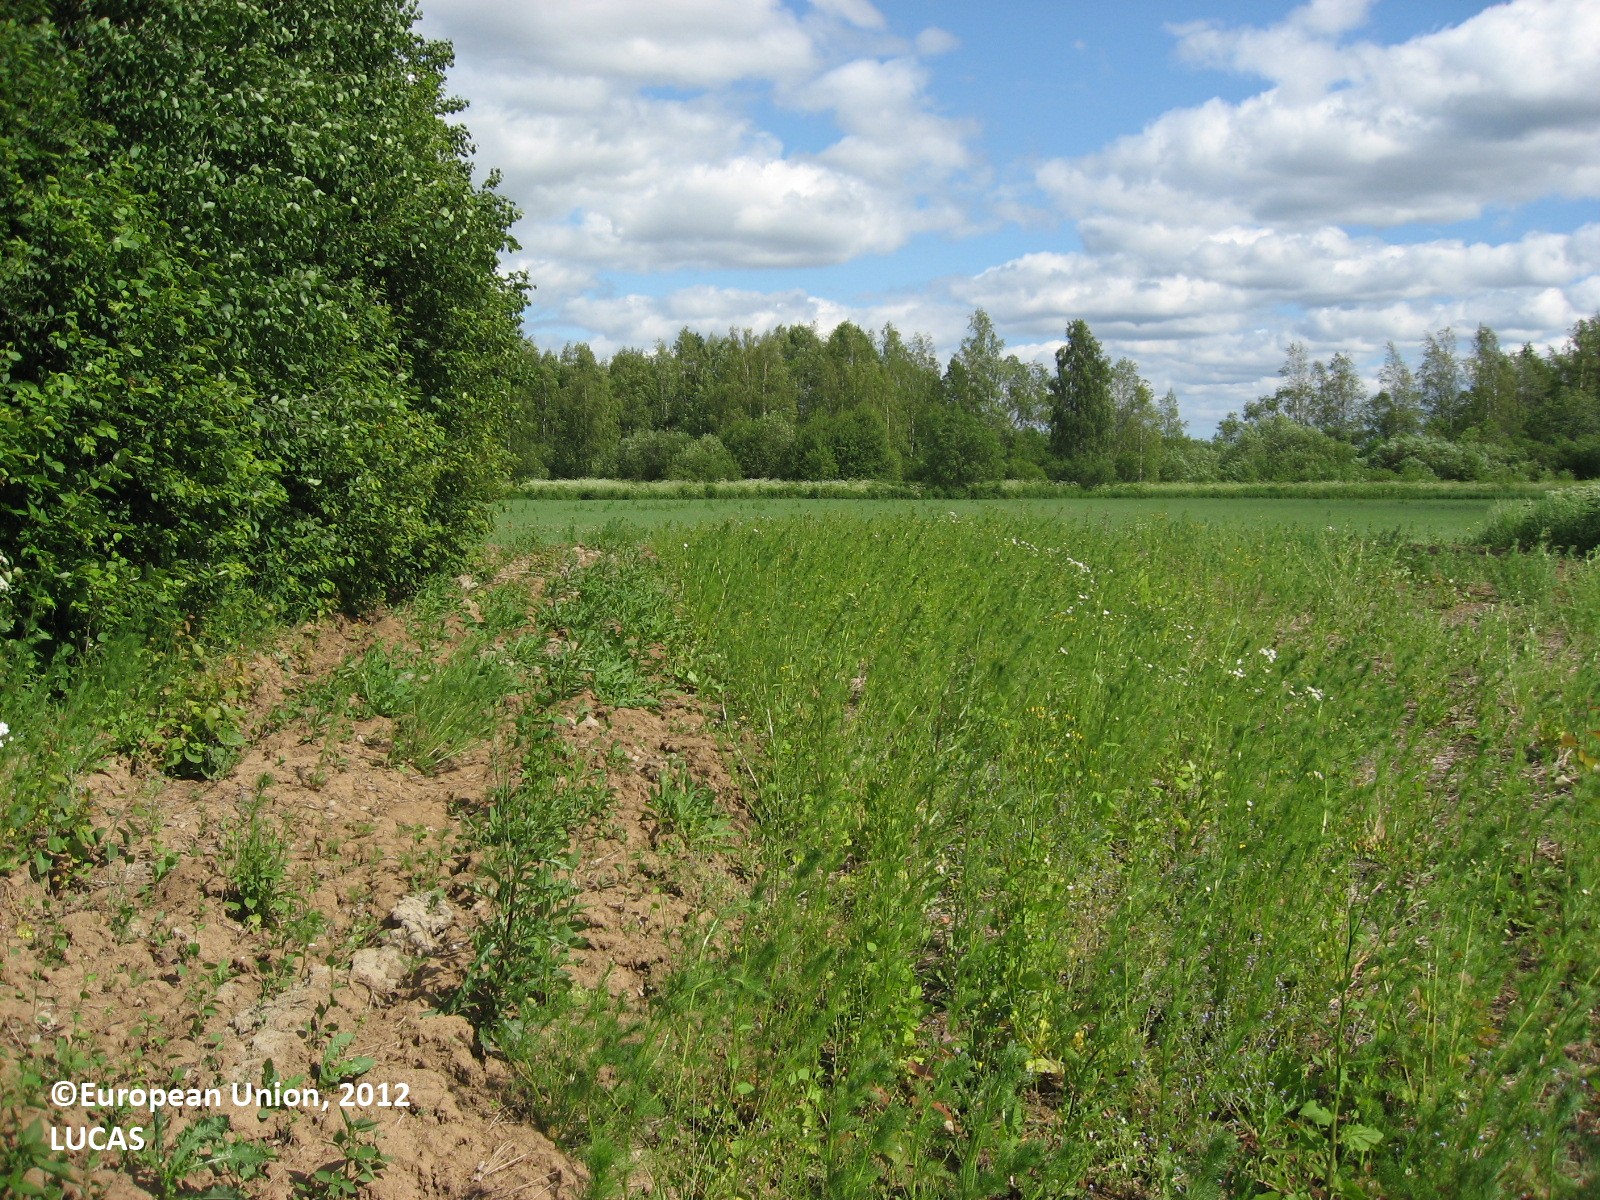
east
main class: Grassland
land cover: Spontaneously vegetated surfaces
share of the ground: 25 - 50 %
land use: Fallow land
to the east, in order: Spontaneously vegetated surfaces; Oats; Single bushes/trees; Spontaneously vegetated surfaces; Broadleaved woodland; Inland marshes
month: June
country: FI
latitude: 60.6054
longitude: 26.4647
